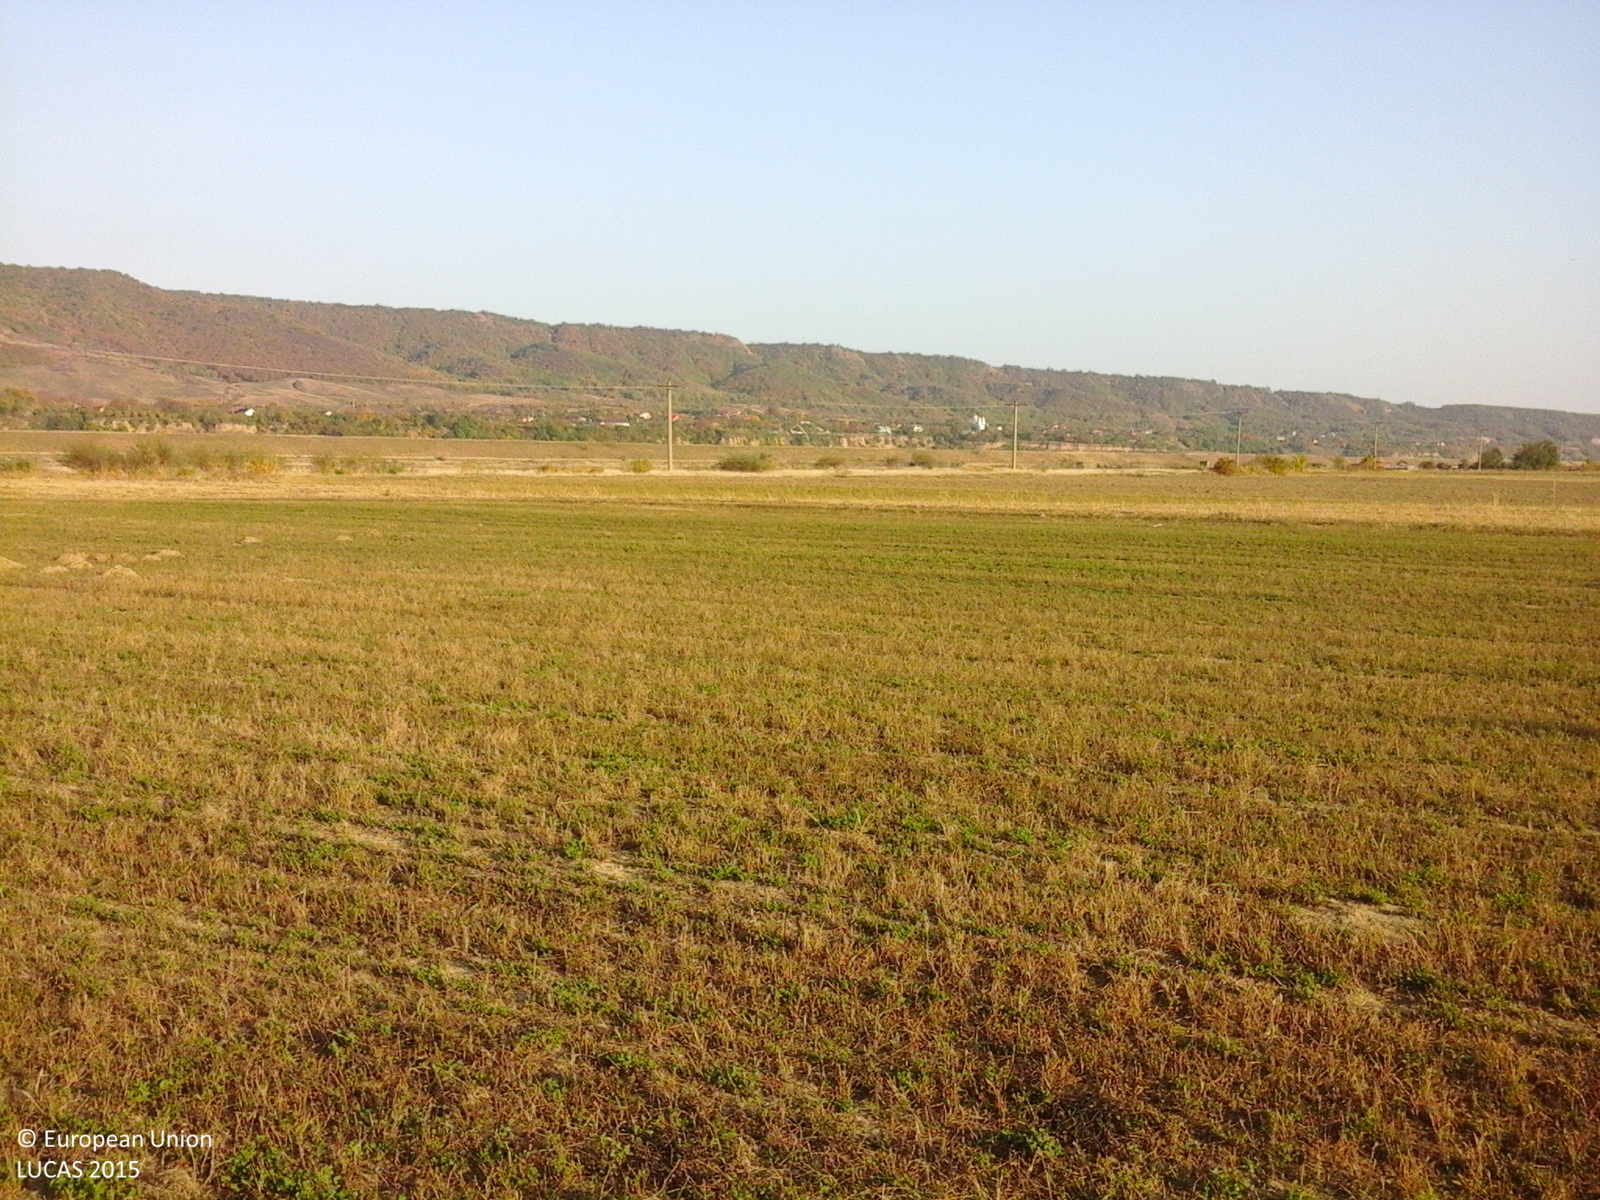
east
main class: Cropland
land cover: Lucerne
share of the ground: 50 - 75 %
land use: Agriculture (excluding fallow land and kitchen gardens)
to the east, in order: Lucerne; Maize; Grassland with sparse tree/shrub cover; Electric lines; Grassland with sparse tree/shrub cover; Tracks; Grassland without tree/shrub cover
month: October
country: RO
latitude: 45.2638
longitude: 26.7094
